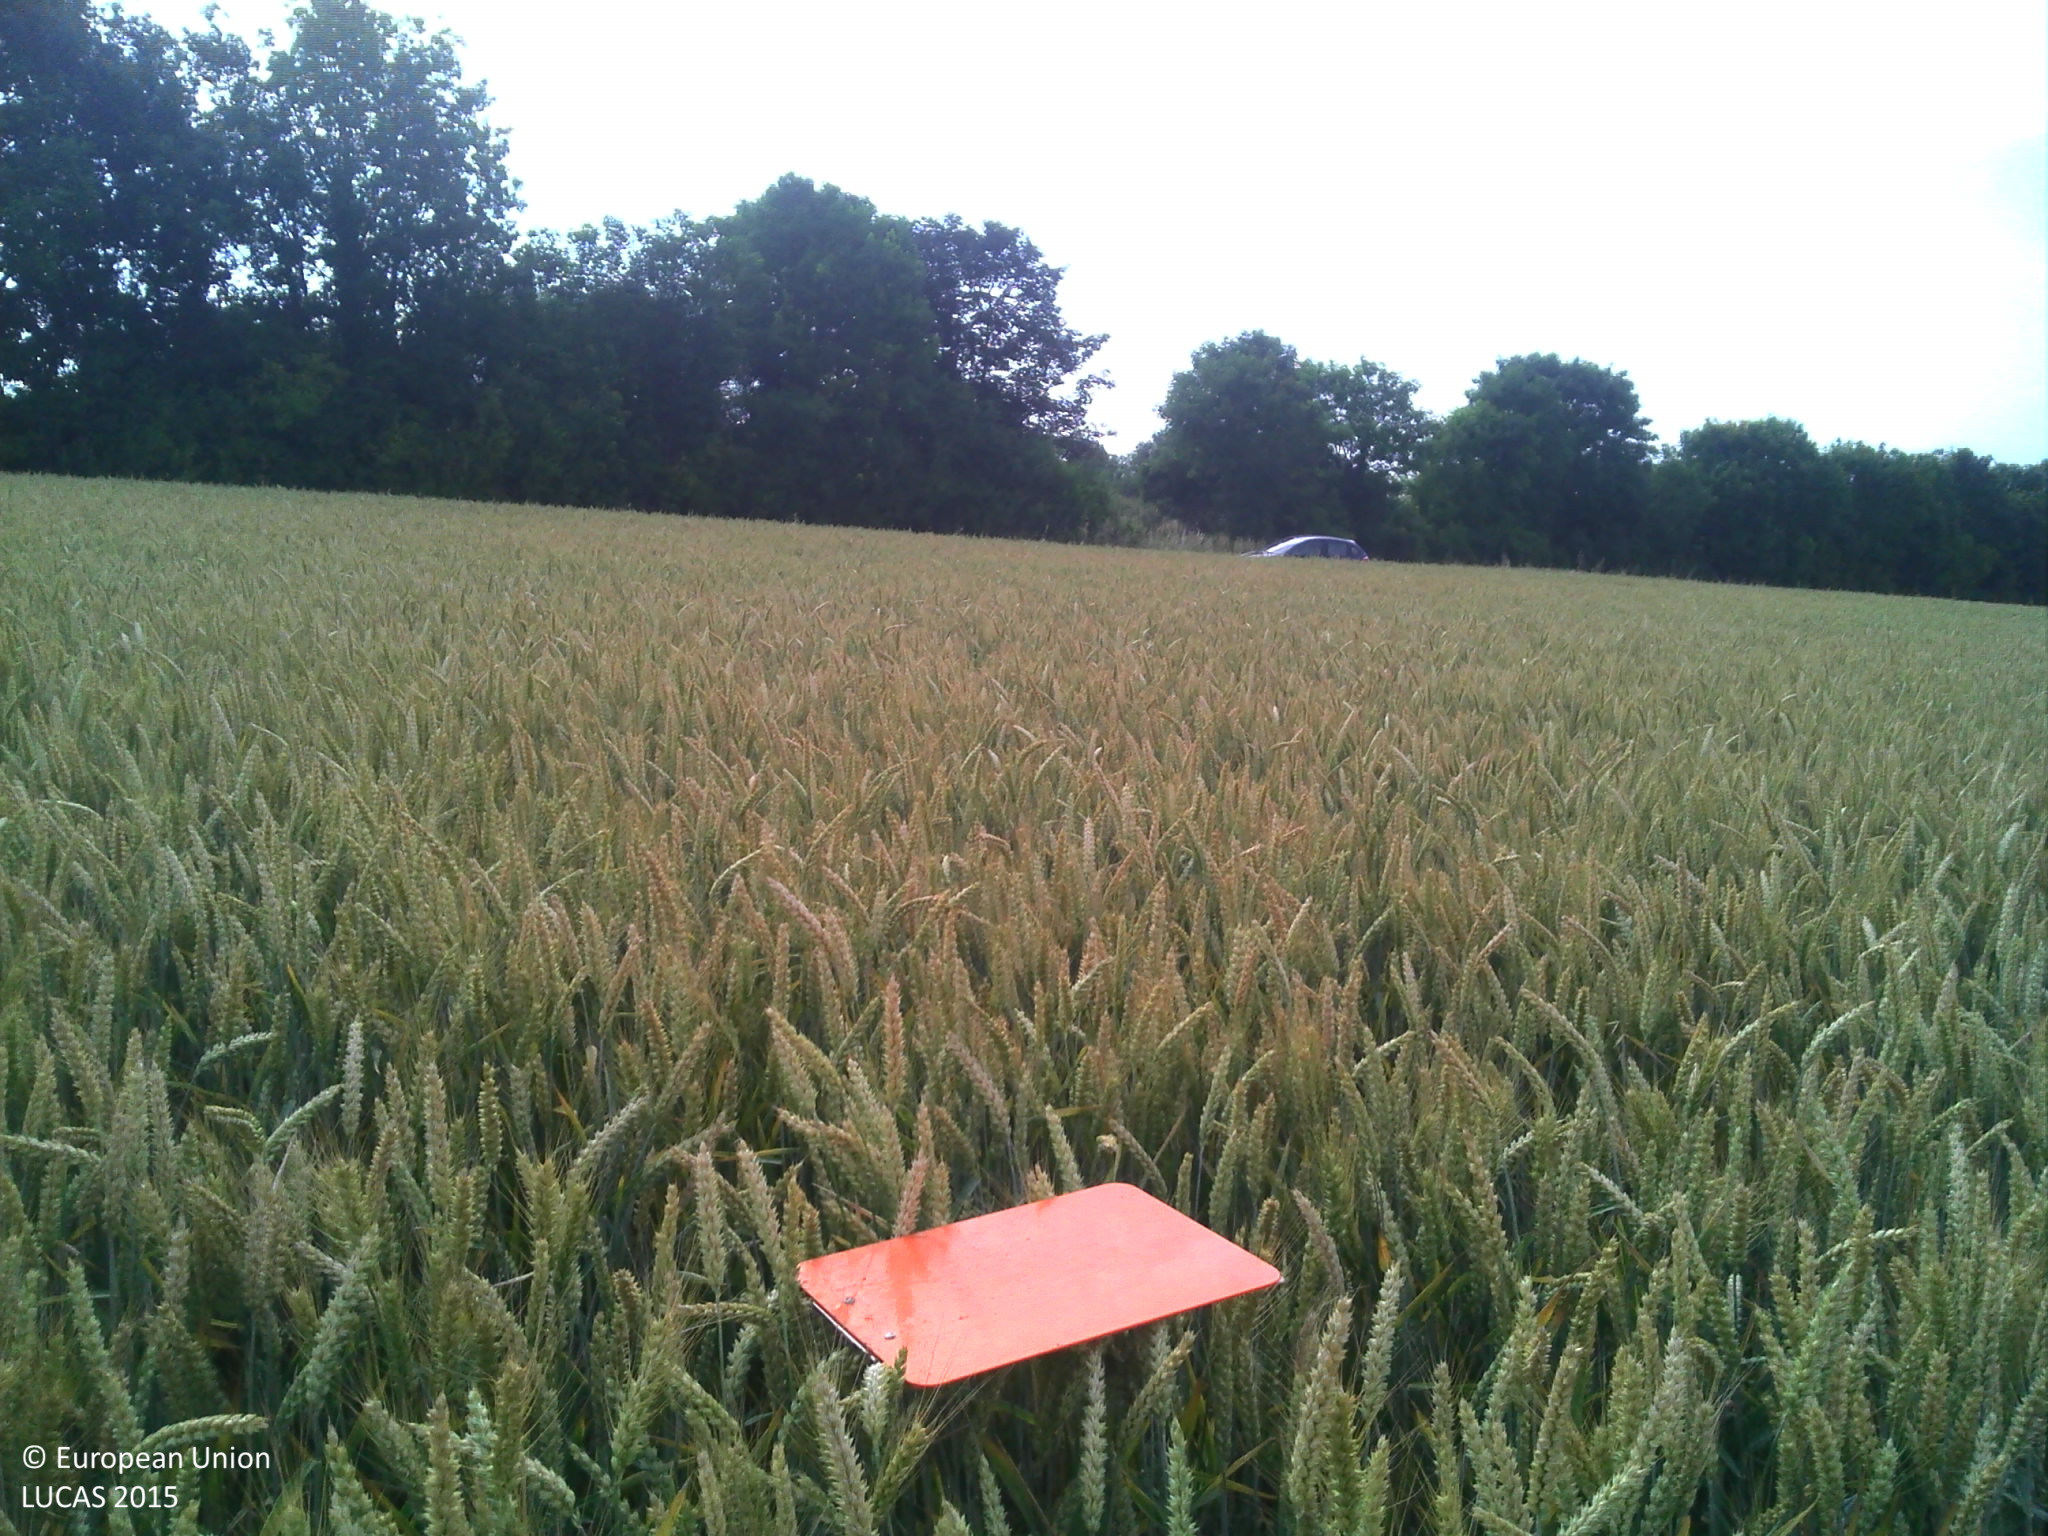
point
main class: Cropland
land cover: Common wheat
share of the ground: > 75 %
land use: Agriculture (excluding fallow land and kitchen gardens)
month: July
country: FR
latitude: 49.7229
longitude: 2.5391
